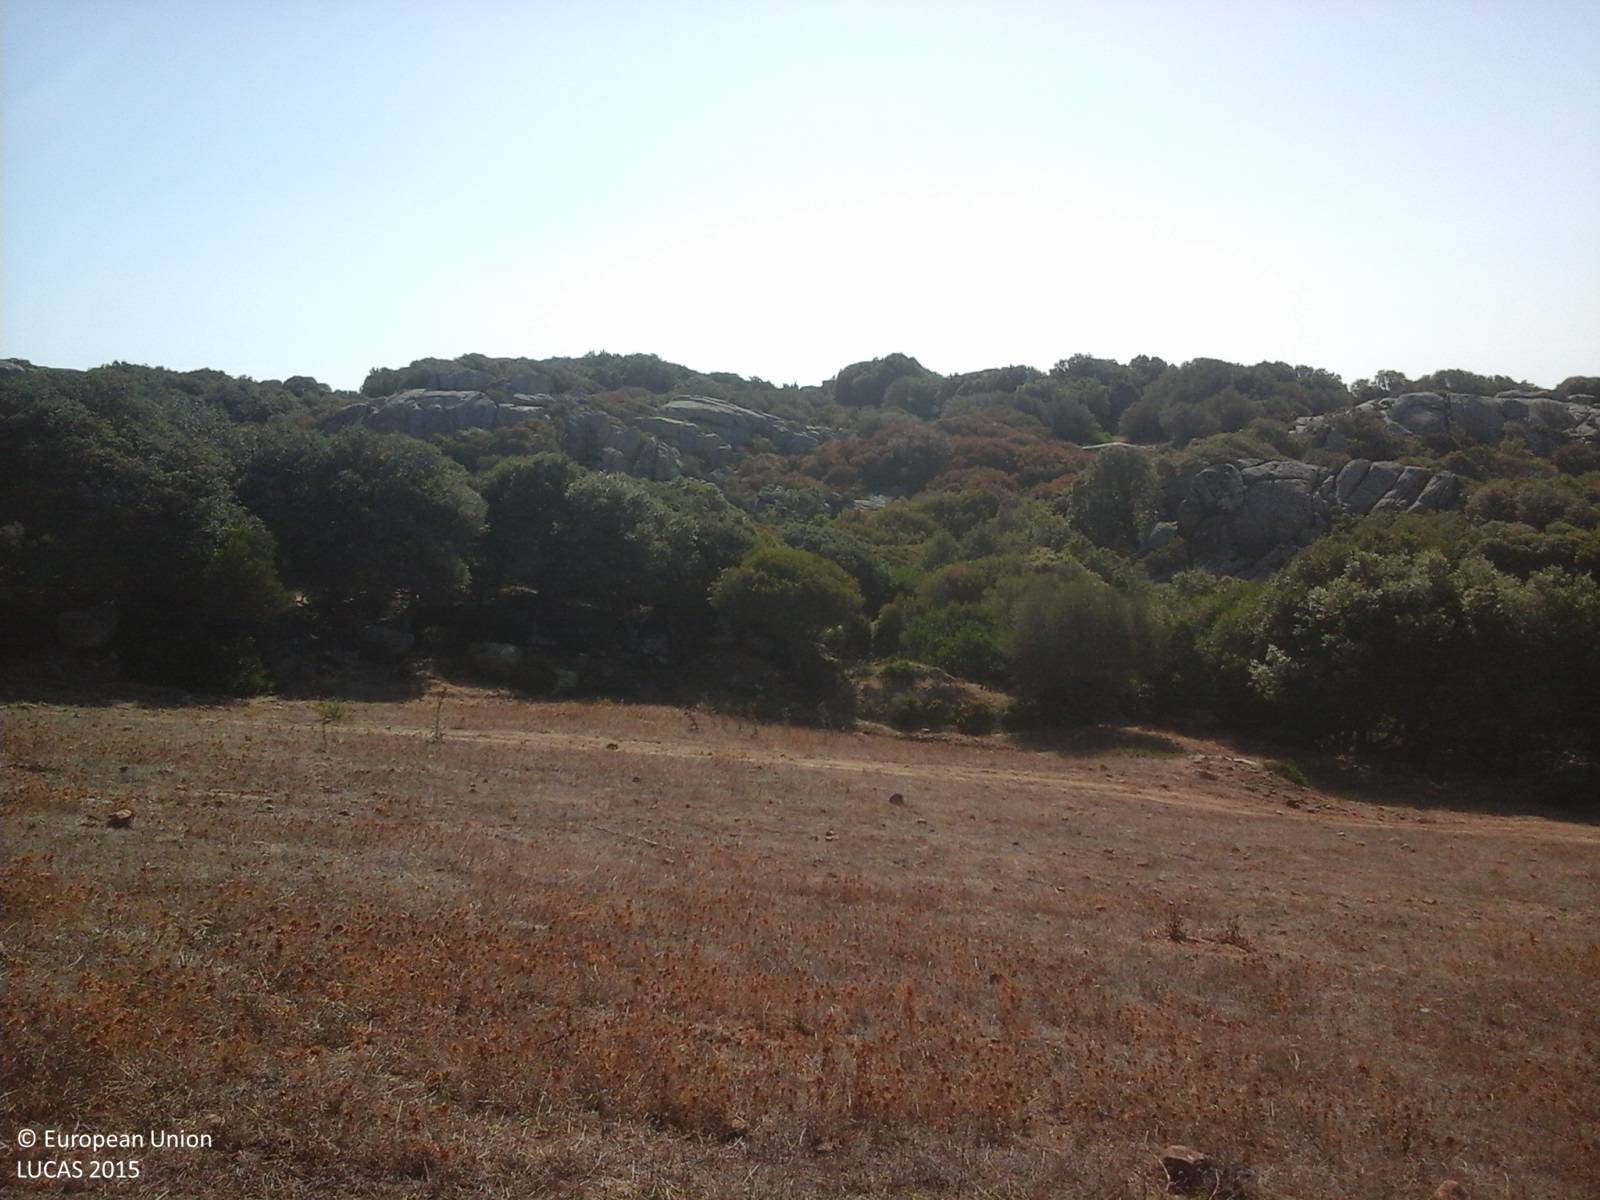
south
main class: Grassland
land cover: Grassland without tree/shrub cover
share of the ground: > 75 %
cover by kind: herbaceous plants 95 %, shrubs 5 %
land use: Agriculture (excluding fallow land and kitchen gardens)
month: September
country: IT
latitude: 41.1148
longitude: 9.2294
